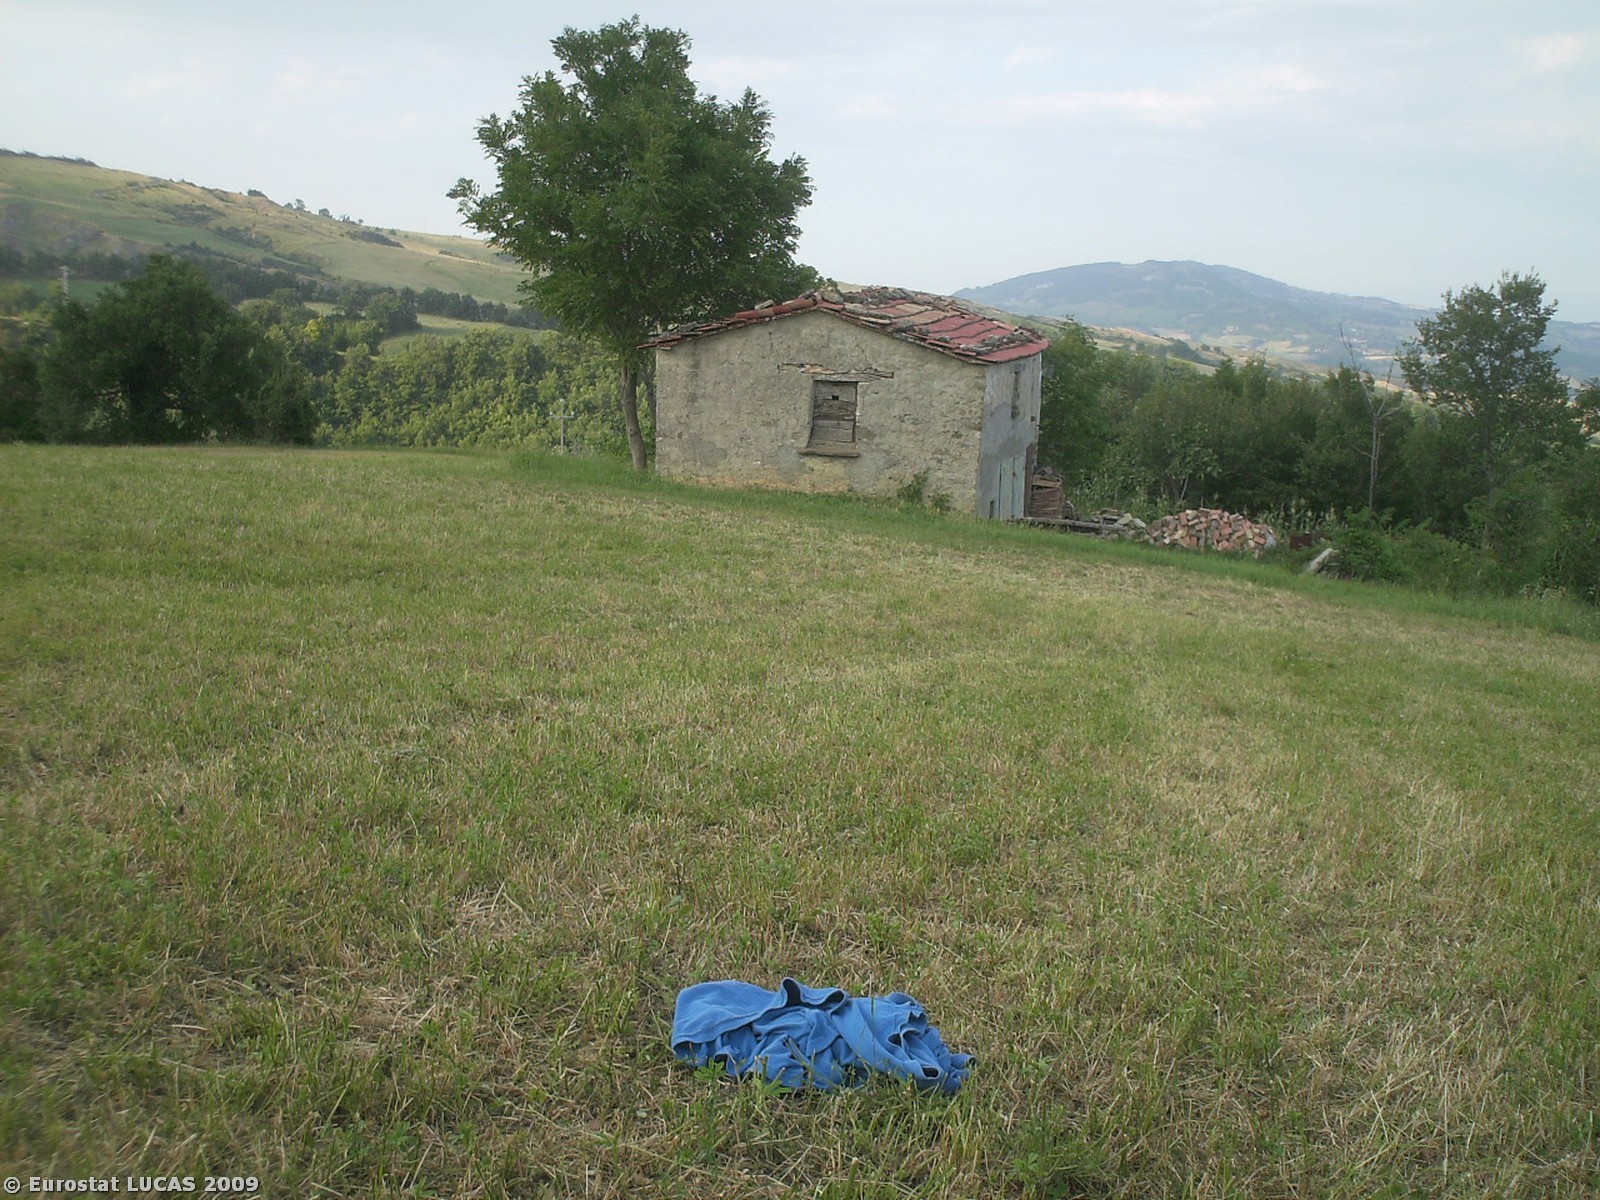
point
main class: Cropland
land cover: Lucerne
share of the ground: 50 - 75 %
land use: Agriculture (excluding fallow land and kitchen gardens)
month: July
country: IT
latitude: 43.8182
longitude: 12.3689
